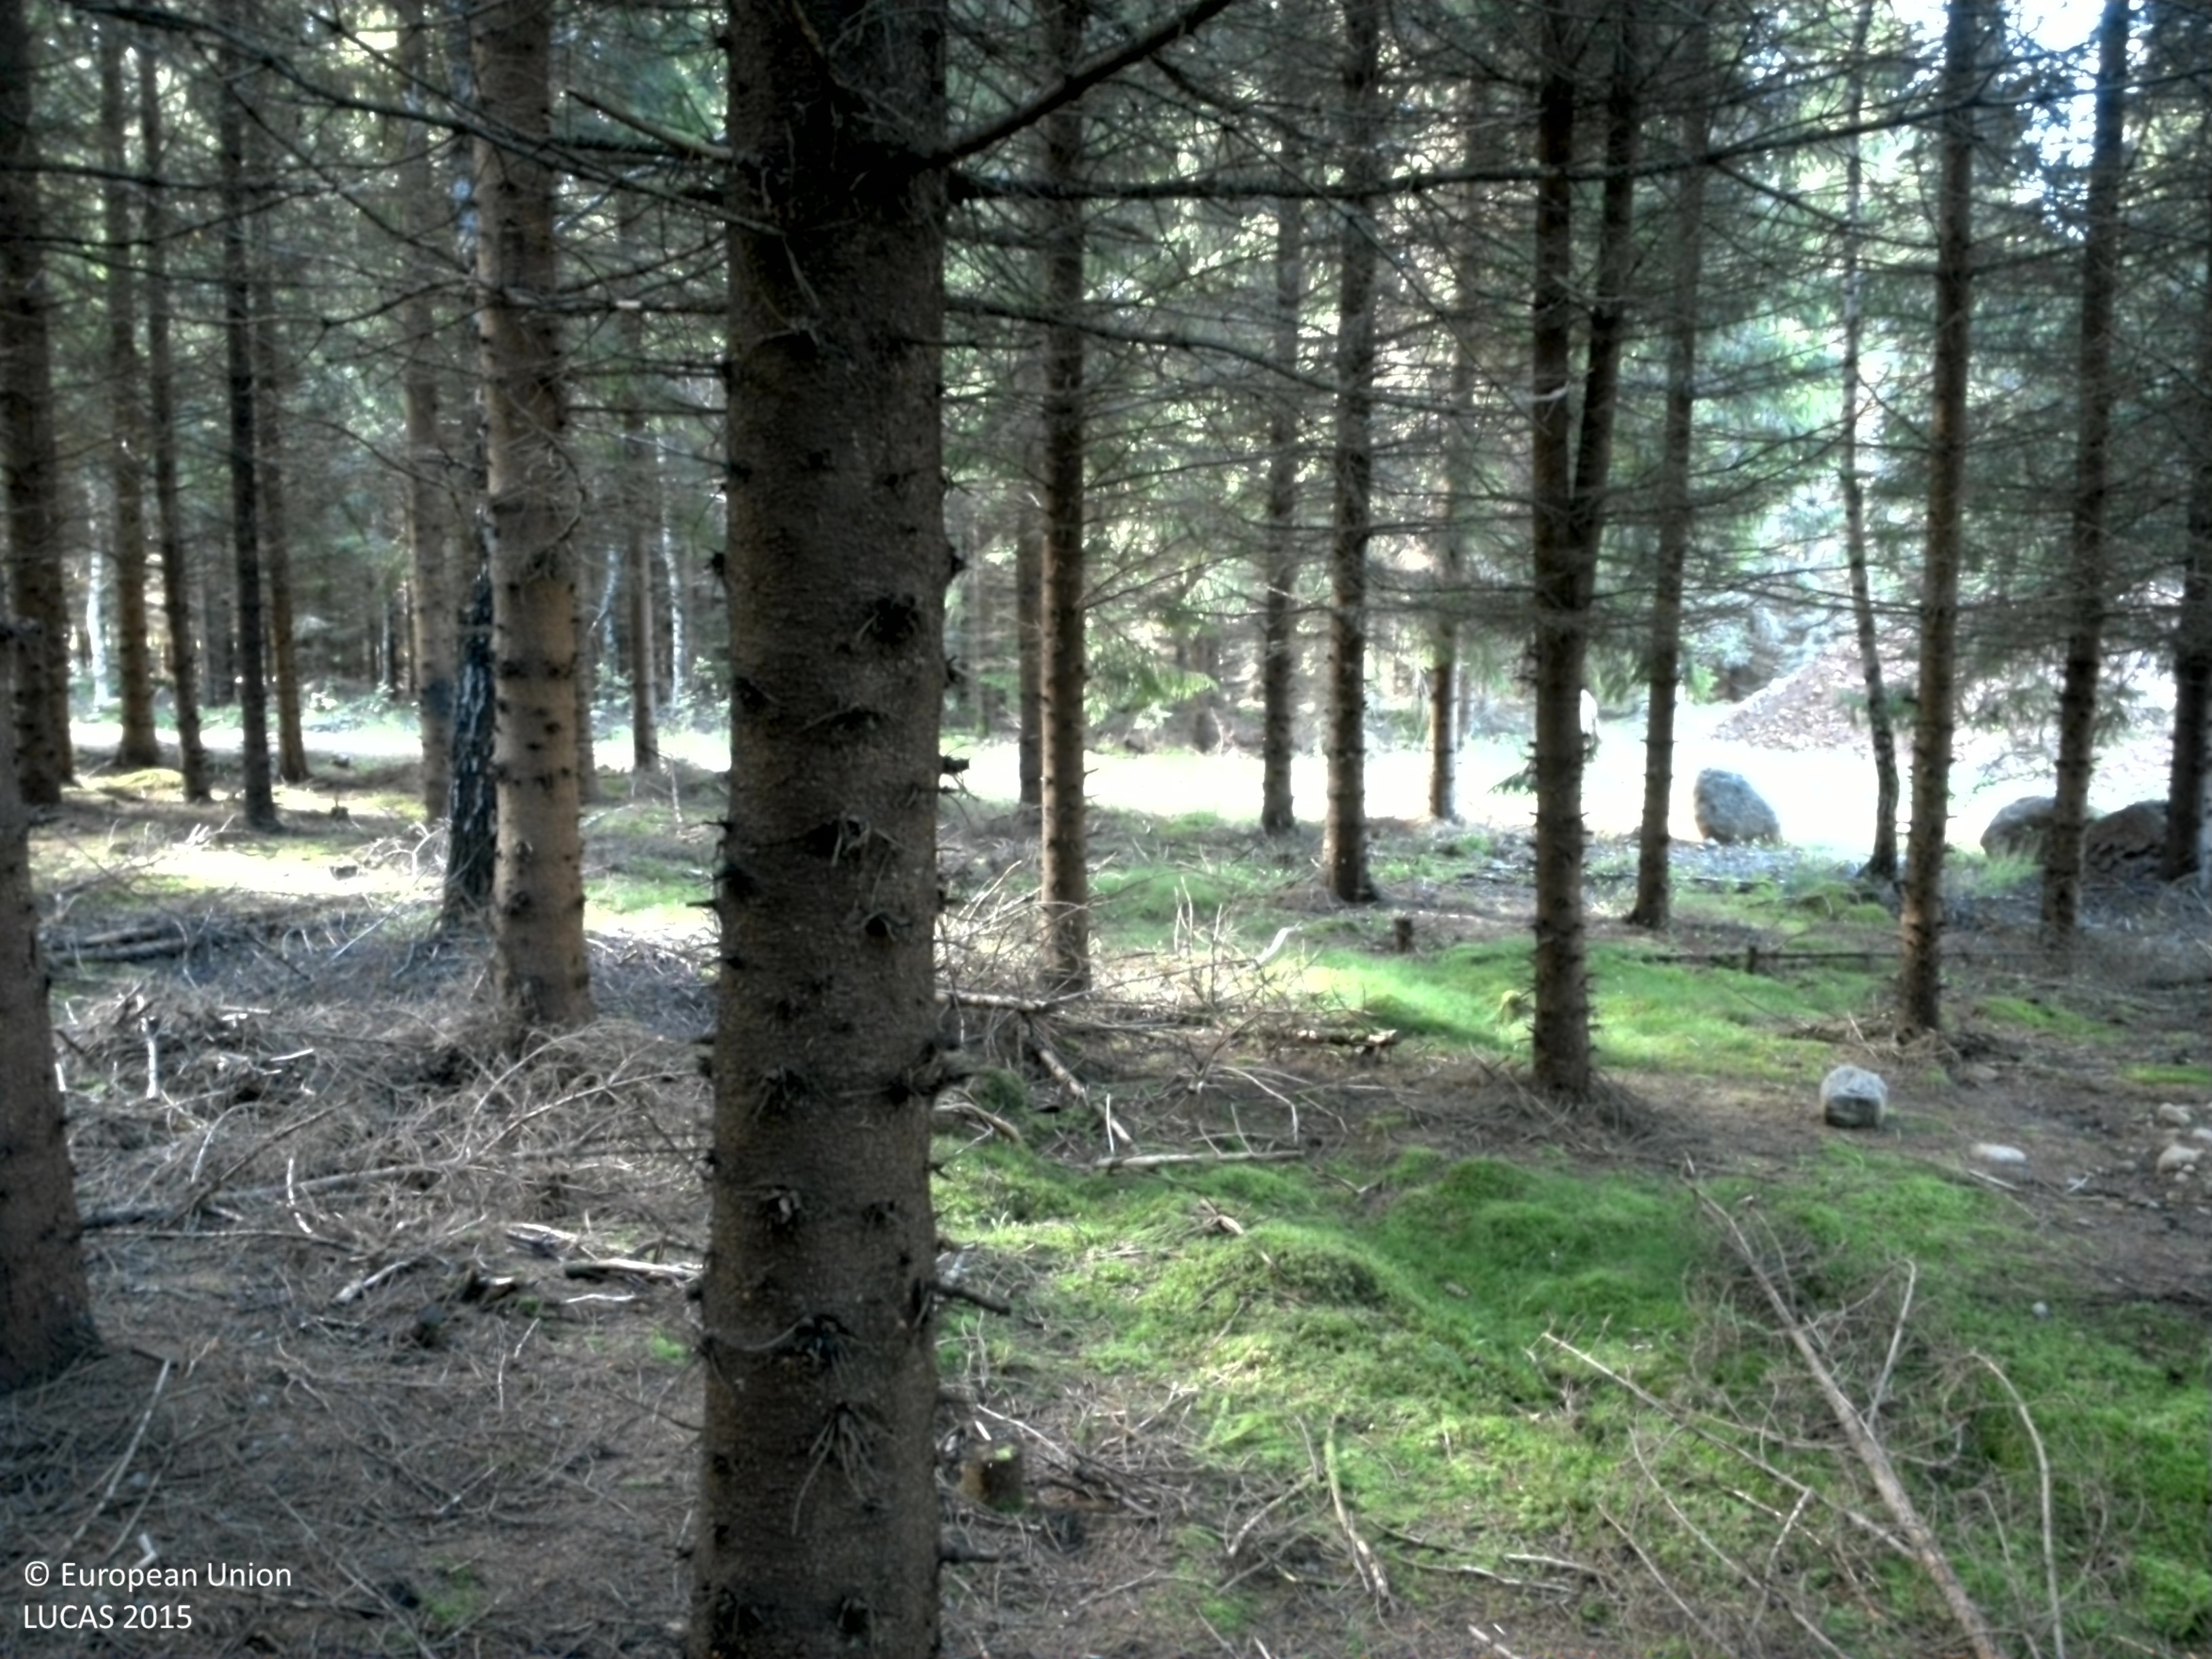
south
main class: Woodland
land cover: Spruce dominated coniferous woodland
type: boreal forest
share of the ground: > 75 %
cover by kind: coniferous forest trees 90 %, lichens and mosses 5 %, unconsolidated bare surface 5 %
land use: Forestry
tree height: > 5 m
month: August
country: SE
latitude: 58.1779
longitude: 13.3443
